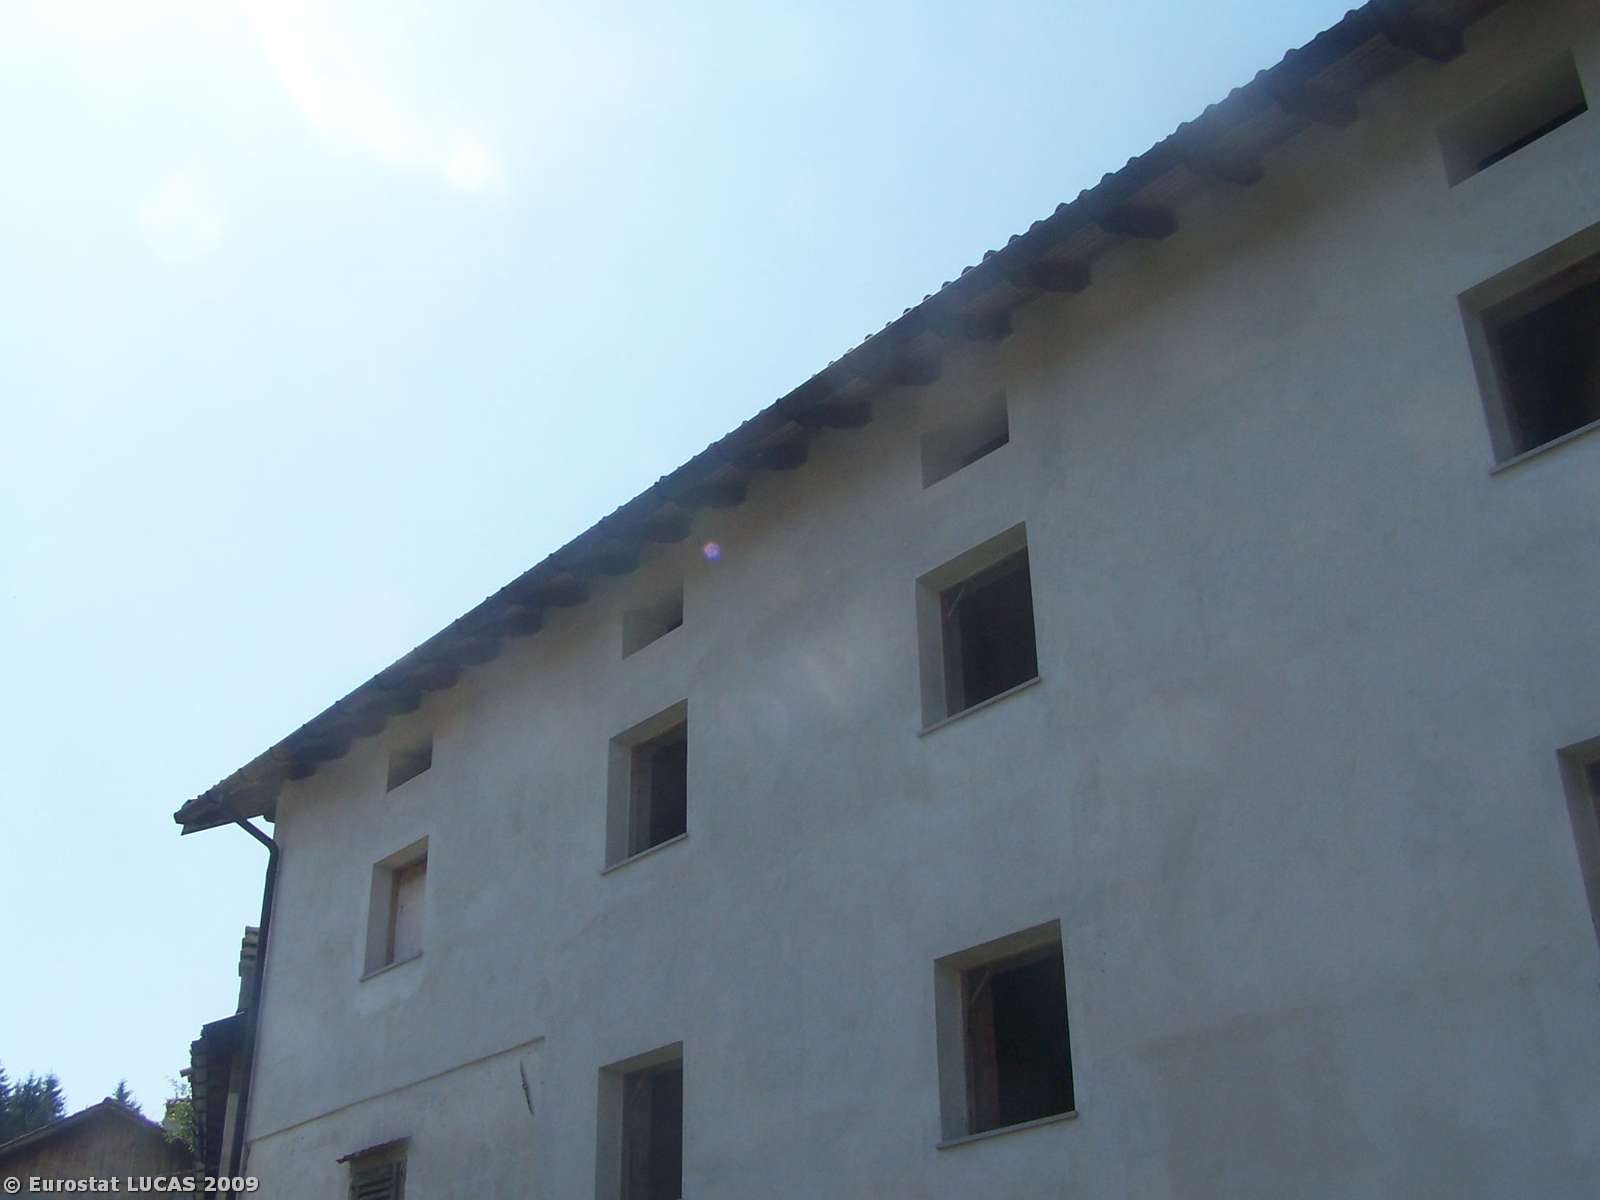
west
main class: Cropland
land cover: Nuts trees
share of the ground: 25 - 50 %
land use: Kitchen garden
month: July
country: IT
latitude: 46.4712
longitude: 13.0054
